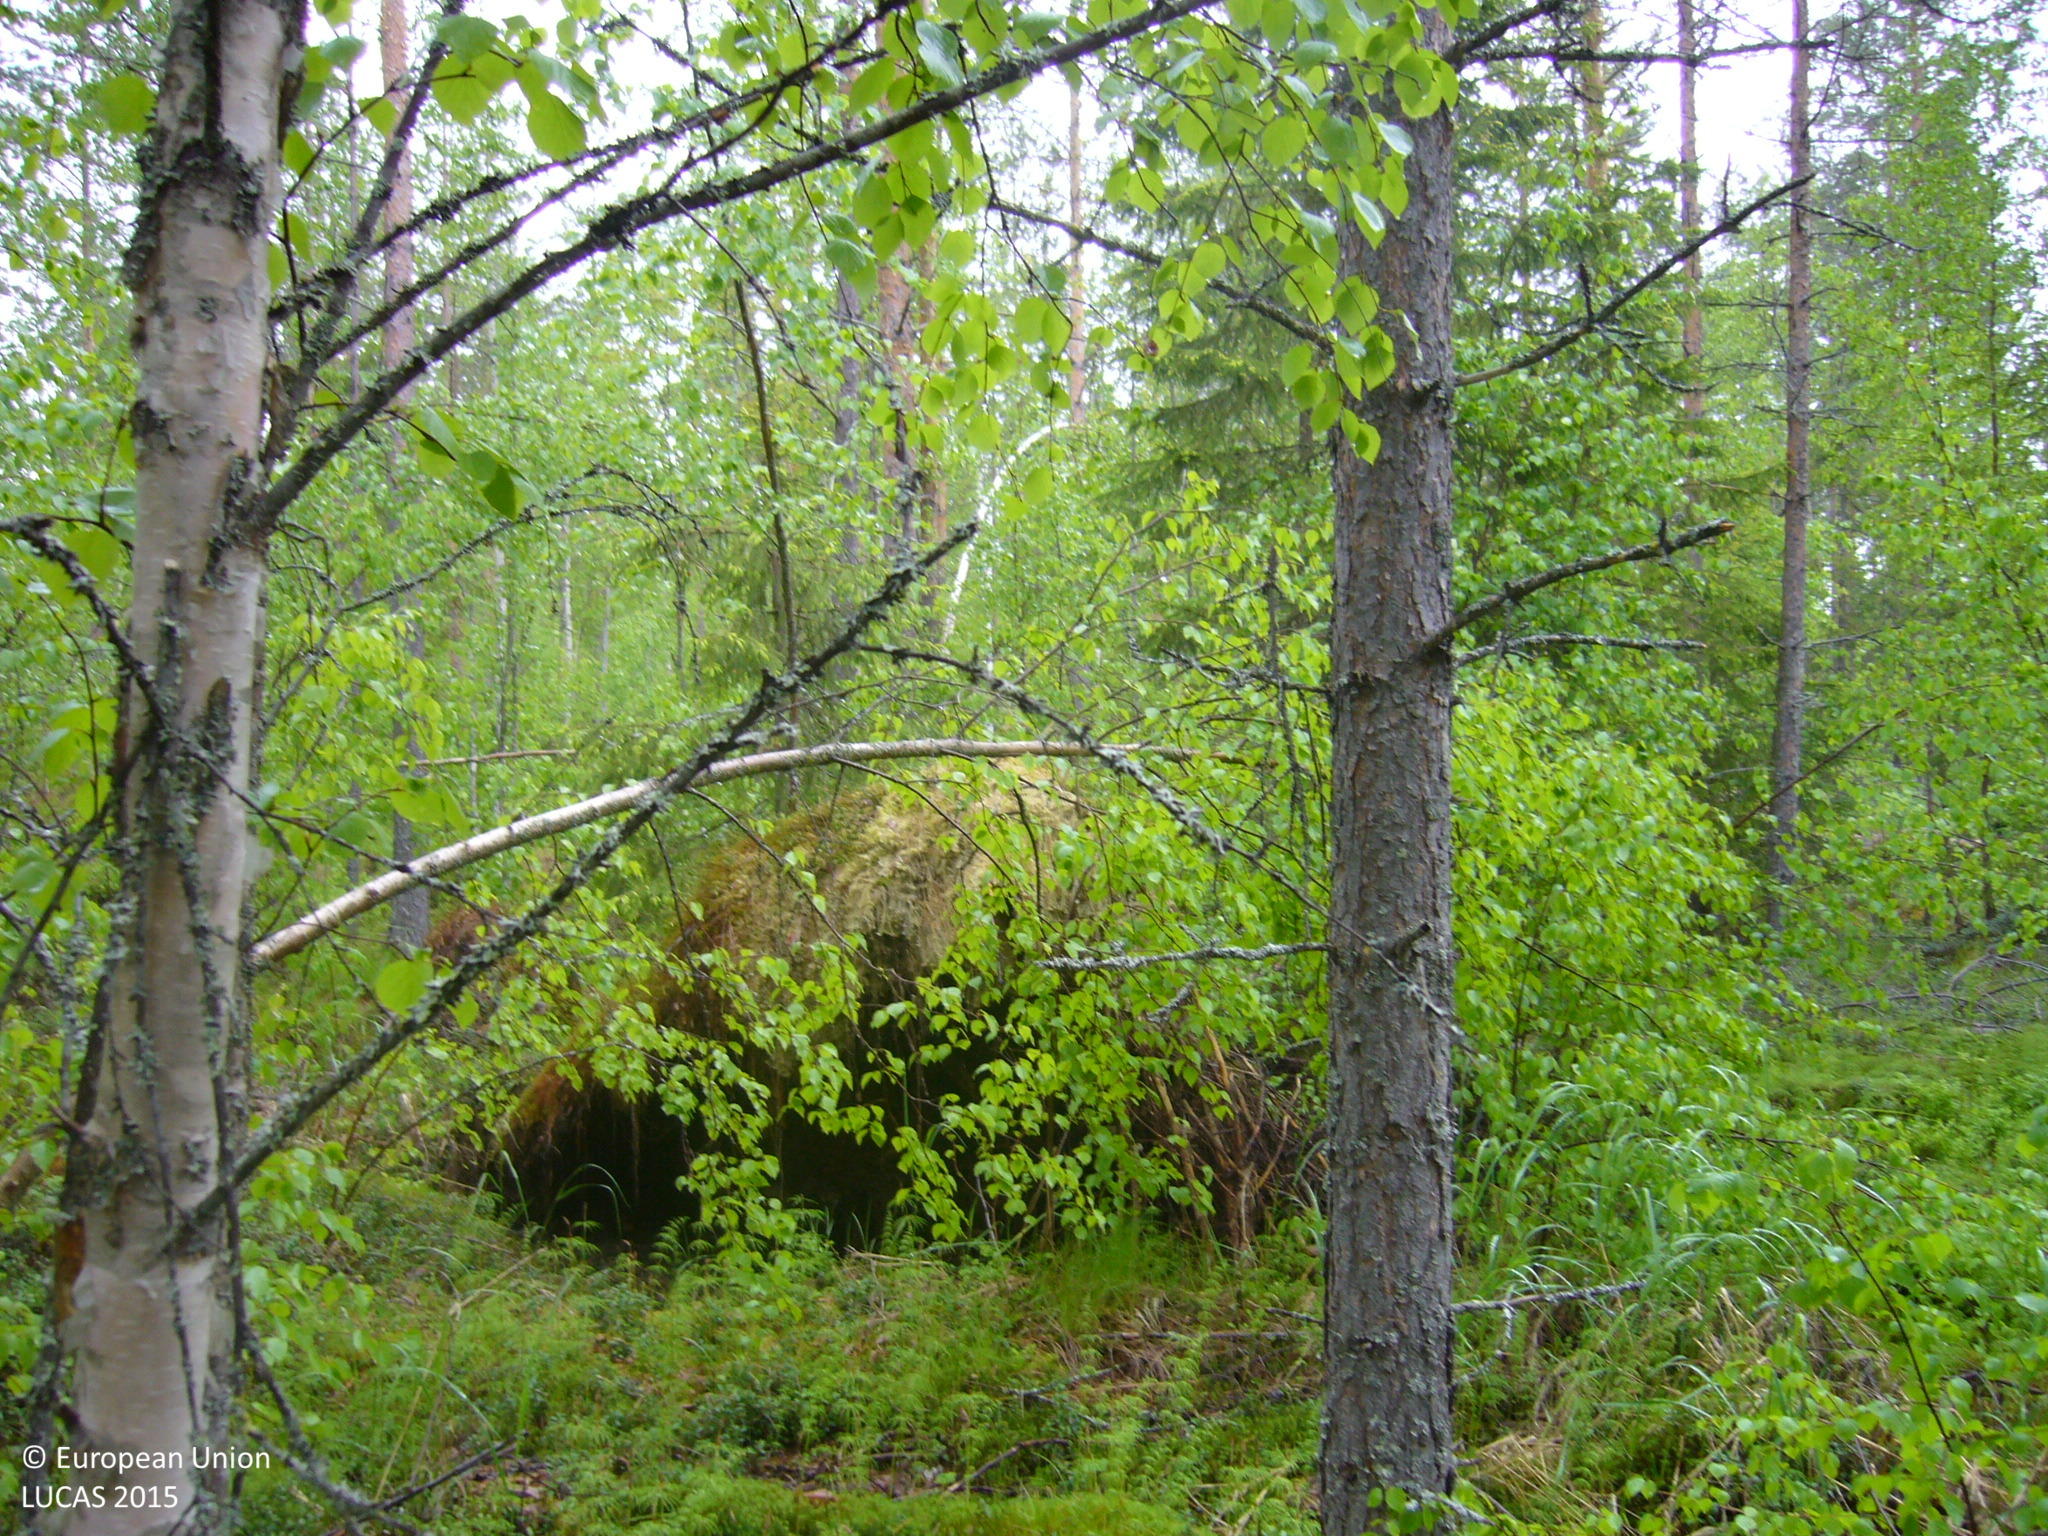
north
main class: Woodland
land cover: Pine dominated mixed woodland
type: boreal forest
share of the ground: 50 - 75 %
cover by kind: broadleaved forest trees 40 %, coniferous forest trees 30 %, shrubs 30 %
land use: Forestry
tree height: > 5 m
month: June
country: FI
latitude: 63.2704
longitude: 26.2851
